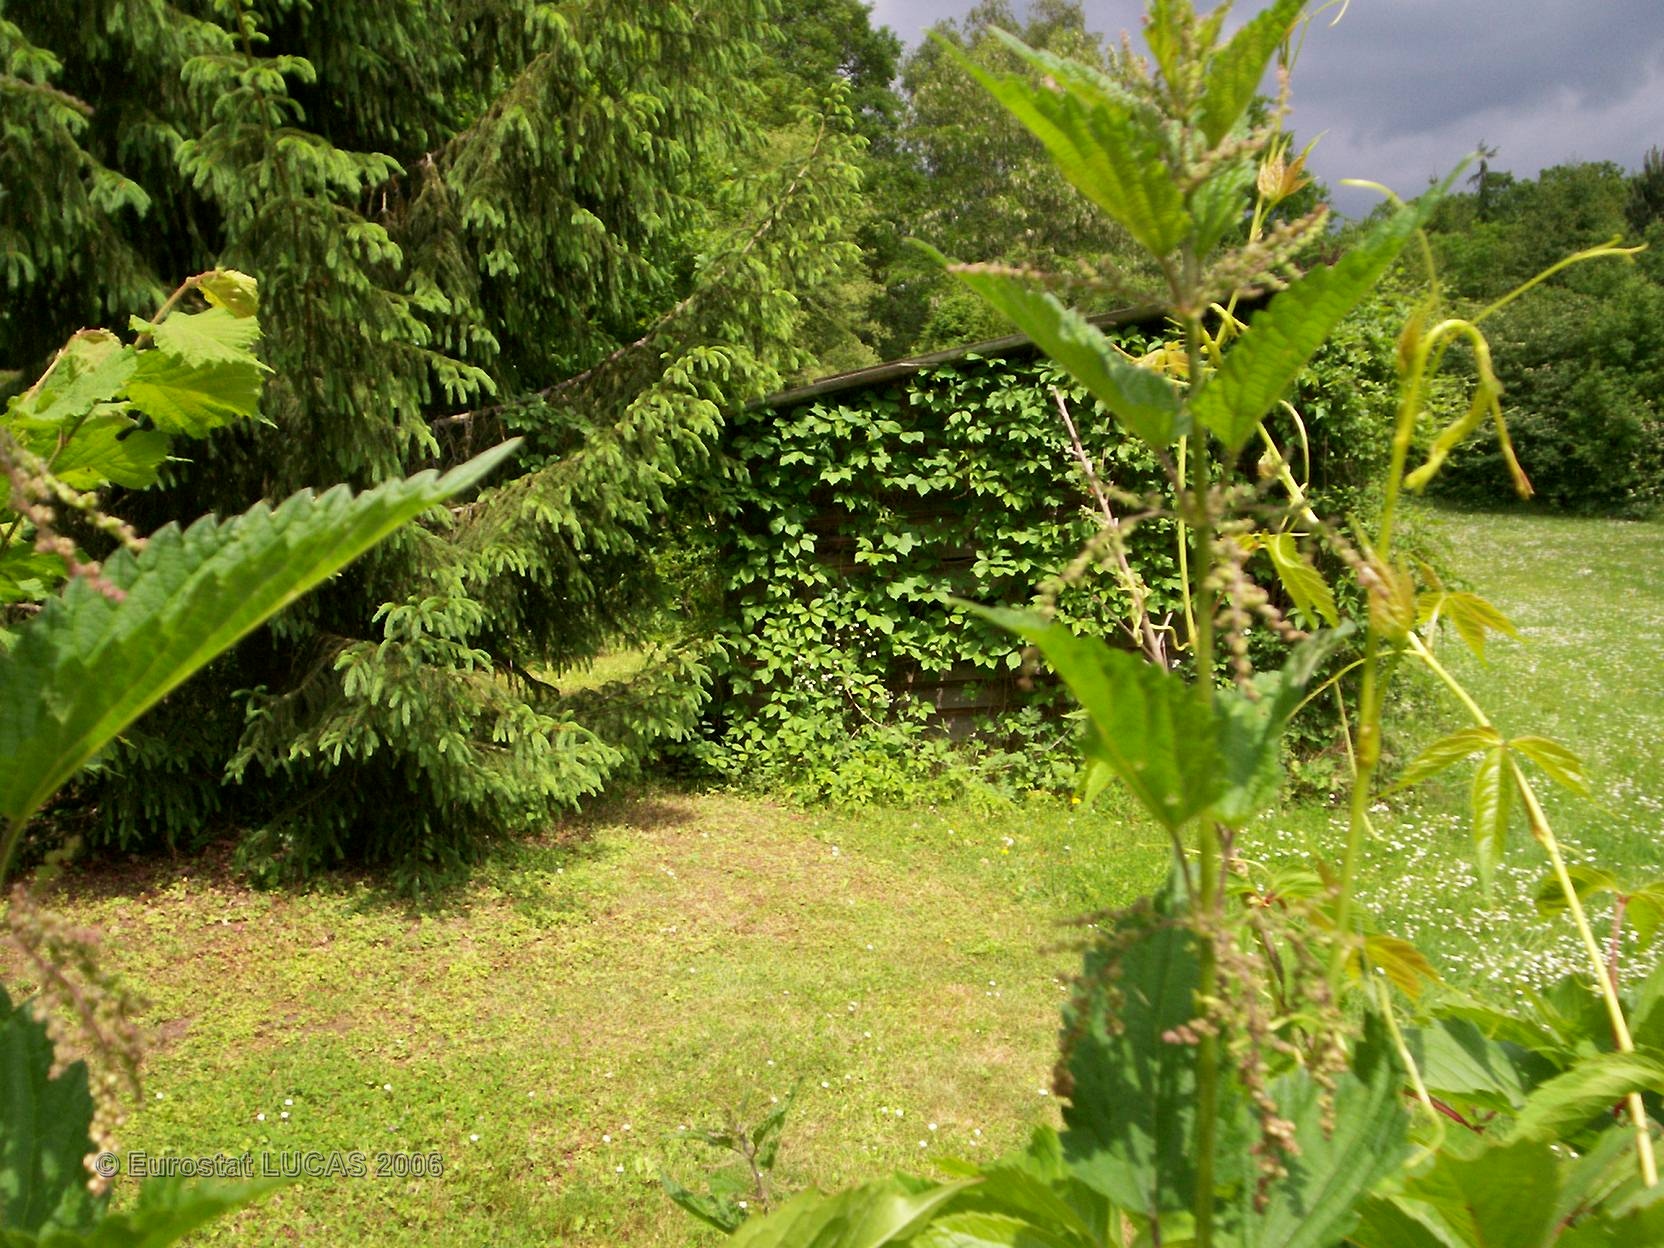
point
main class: Grassland
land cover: Grassland with sparse tree/shrub cover
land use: Residential
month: May
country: FR
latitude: 48.4548
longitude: 2.7567
